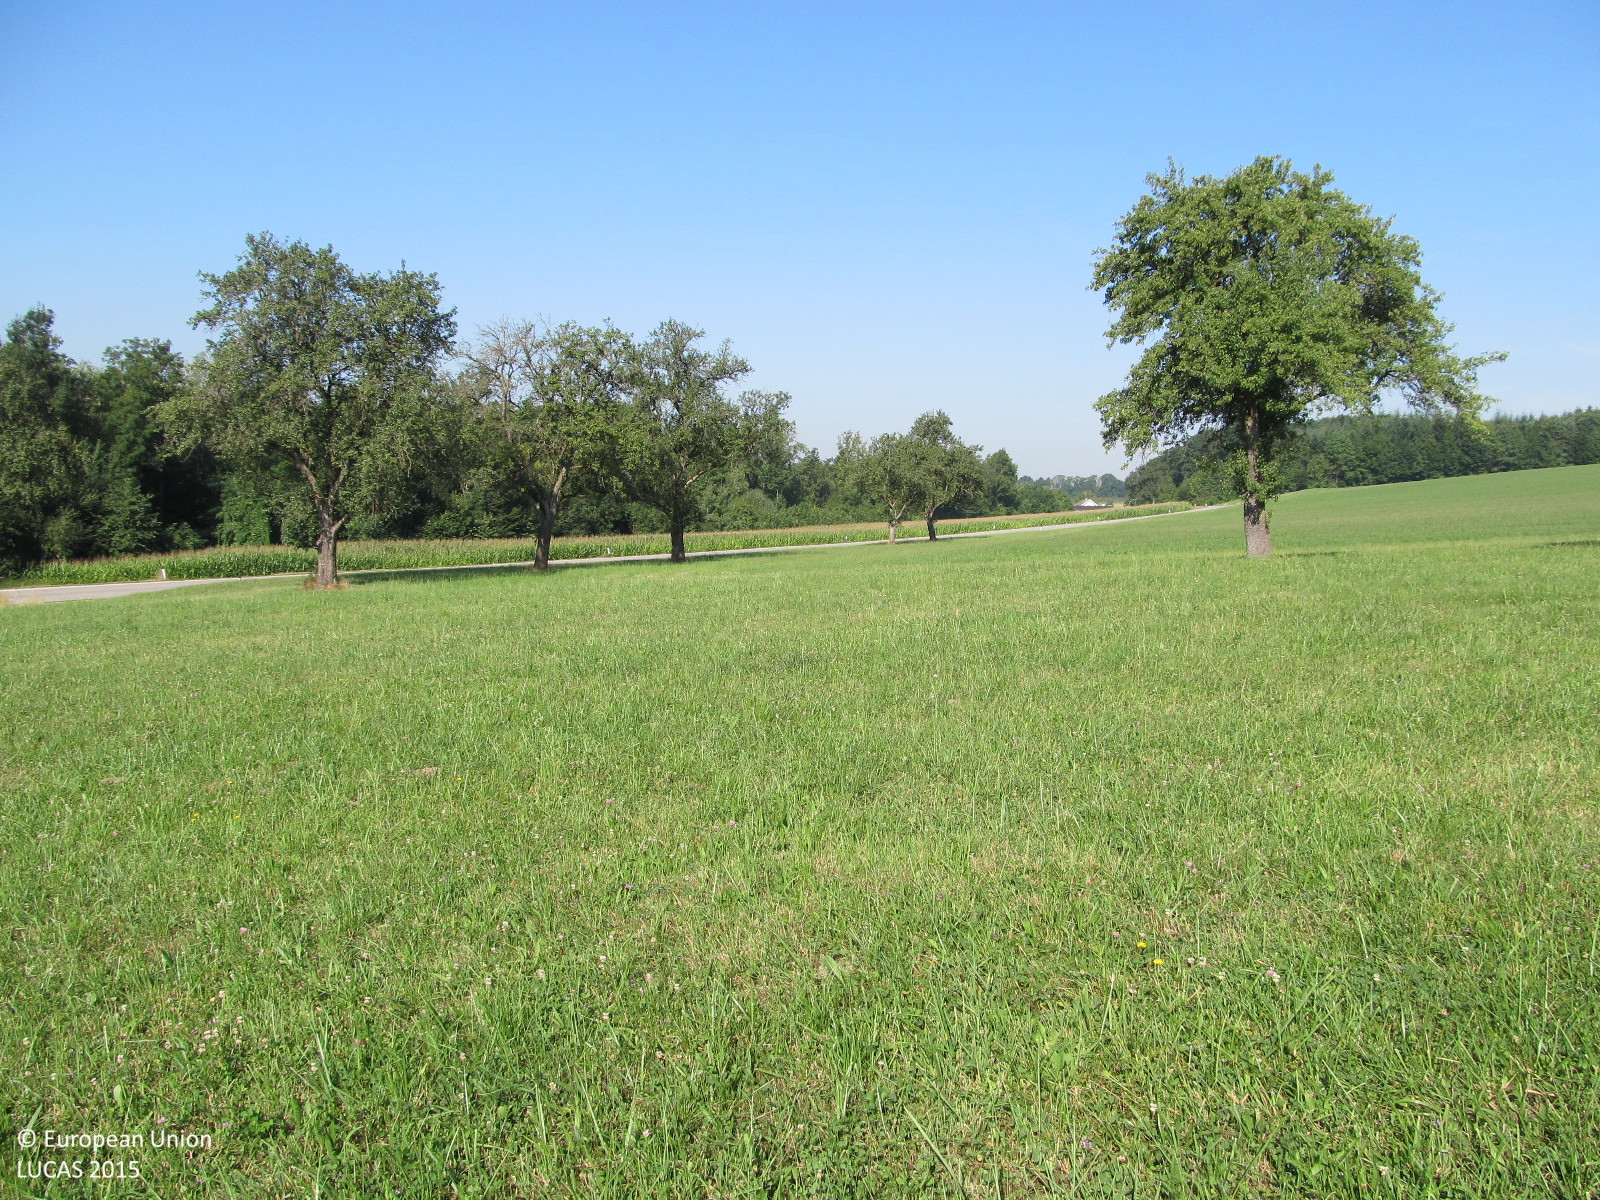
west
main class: Grassland
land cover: Grassland without tree/shrub cover
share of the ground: > 75 %
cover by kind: herbaceous plants 100 %
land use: Agriculture (excluding fallow land and kitchen gardens)
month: August
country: AT
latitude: 48.1171
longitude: 15.6040
